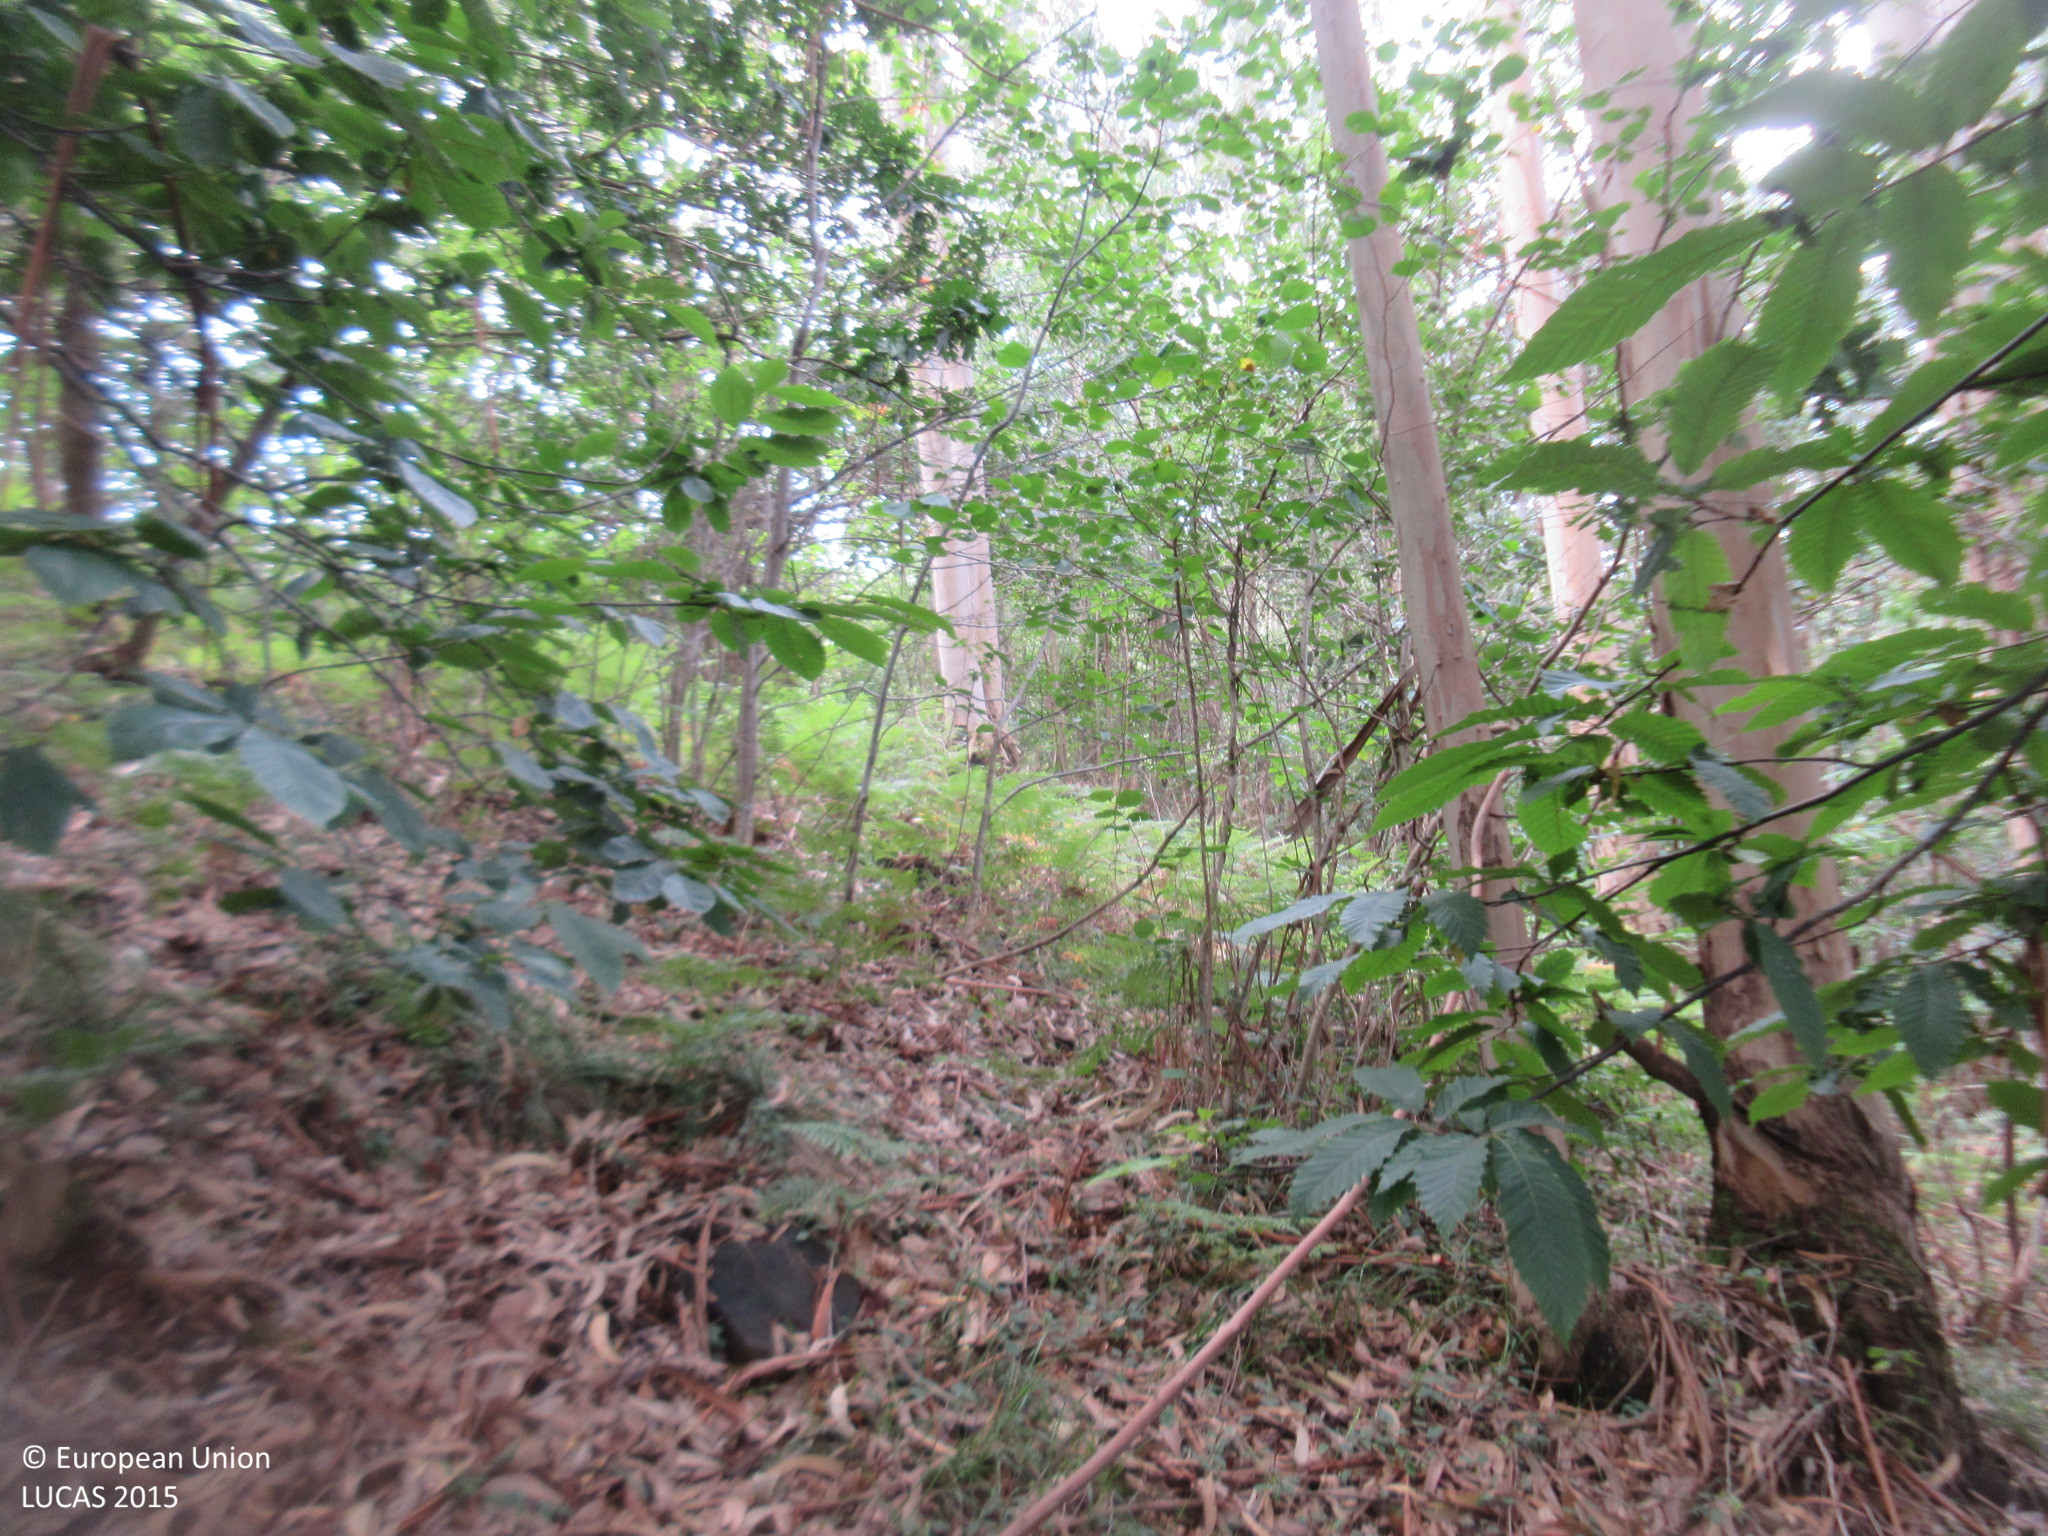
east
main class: Woodland
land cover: Broadleaved woodland
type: exotic forest
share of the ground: > 75 %
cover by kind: broadleaved forest trees 95 %, shrubs 5 %
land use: Forestry
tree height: > 5 m
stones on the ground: < 10 %
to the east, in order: Broadleaved woodland; Grassland without tree/shrub cover; Groves; Grass margins; Electric lines; Paved roads, cycling and walking lanes; Grass margins; Electric lines; Grassland without tree/shrub cover
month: July
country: ES
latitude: 43.3198
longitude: -4.0223
